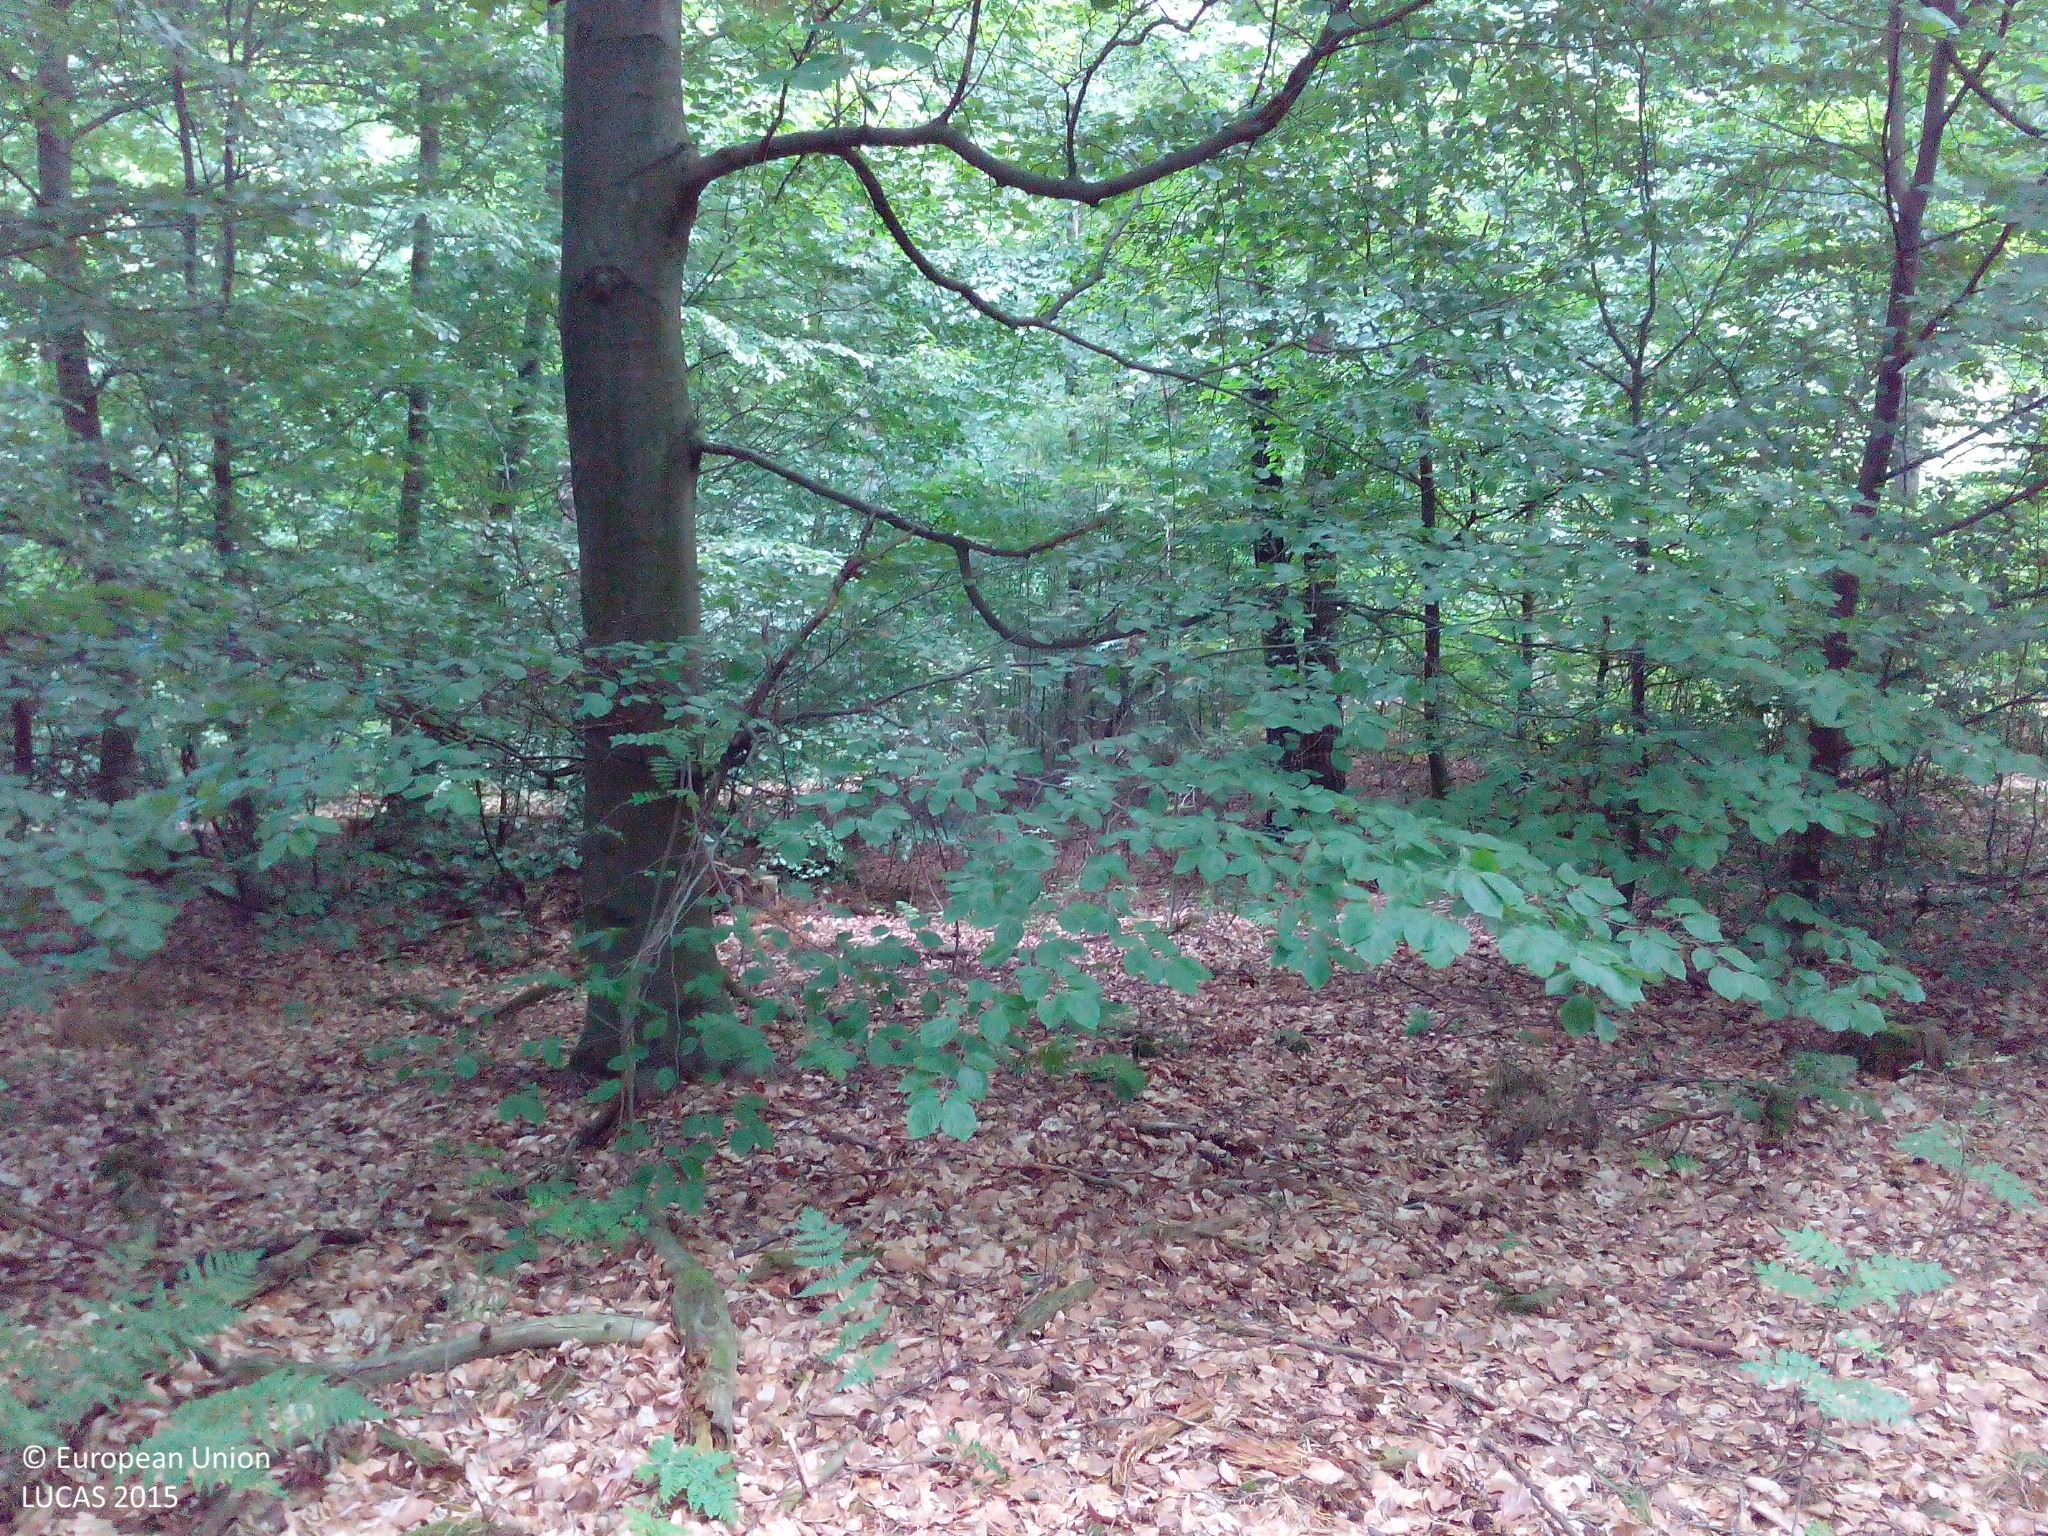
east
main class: Woodland
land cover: Pine dominated mixed woodland
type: hemiboreal forest and nemoral coniferous forest and mixed broadleaved-coniferous forest
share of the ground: > 75 %
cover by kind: coniferous forest trees 50 %, broadleaved forest trees 45 %, shrubs 5 %
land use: Forestry
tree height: > 5 m
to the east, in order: Pine dominated mixed woodland; Tracks; Broadleaved woodland
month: July
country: DE
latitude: 52.7547
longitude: 13.6007
